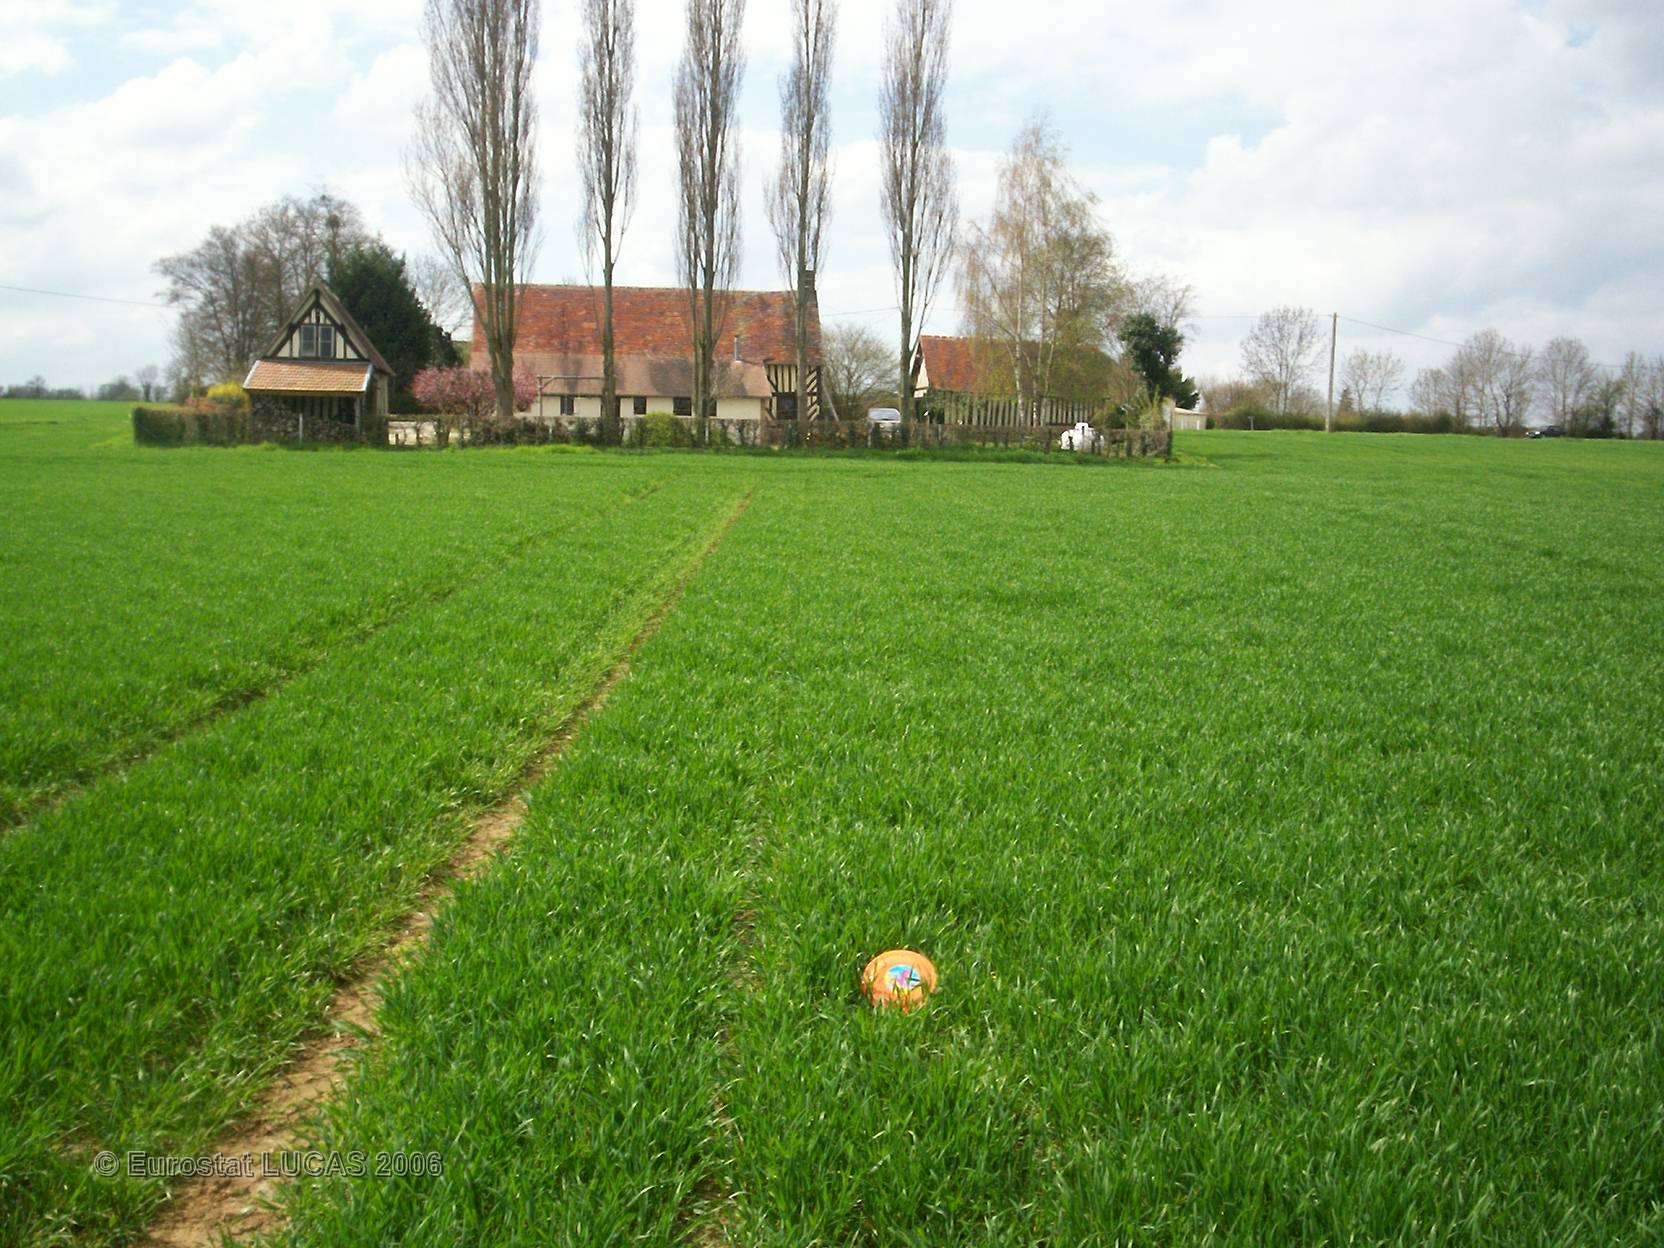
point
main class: Cropland
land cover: Common wheat
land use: Agriculture (excluding fallow land and kitchen gardens)
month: April
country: FR
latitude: 49.0187
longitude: 0.0009
